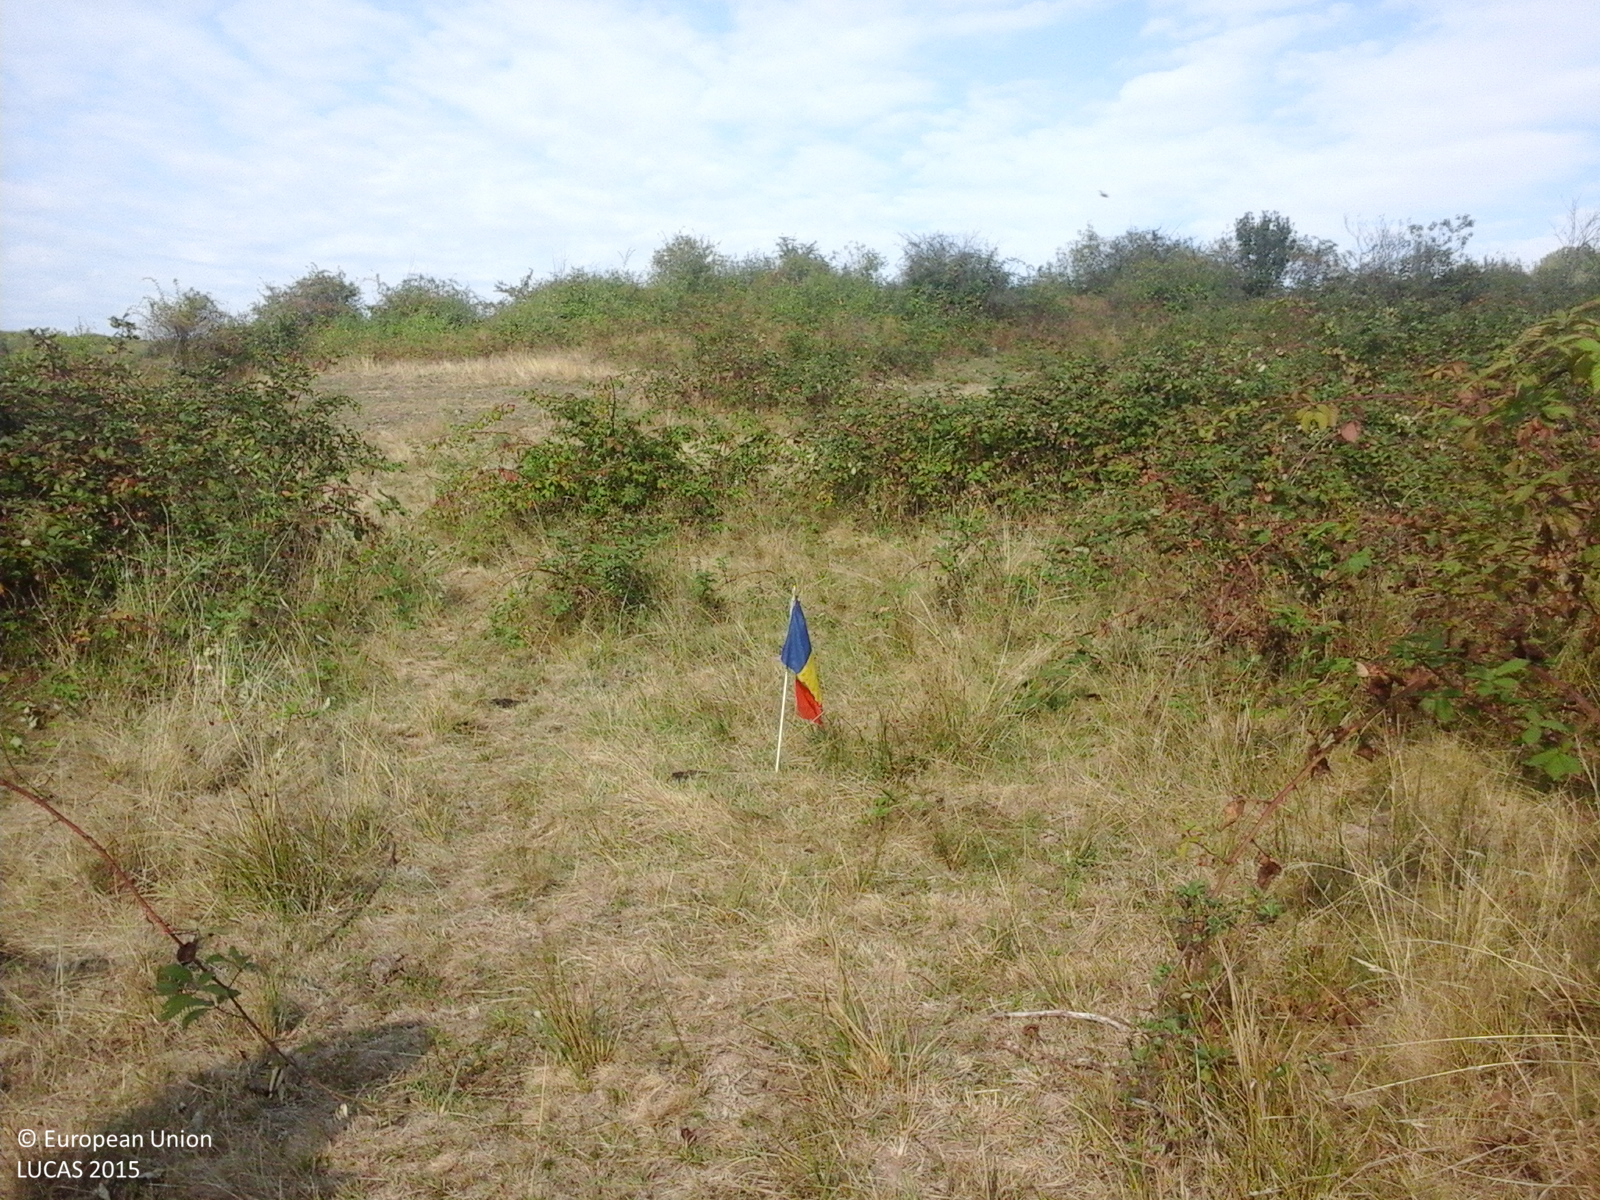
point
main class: Grassland
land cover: Grassland with sparse tree/shrub cover
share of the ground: > 75 %
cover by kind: herbaceous plants 85 %, shrubs 10 %, broadleaved forest trees 5 %
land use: Fallow land
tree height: < 5 m
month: September
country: RO
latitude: 47.8201
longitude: 23.2539
